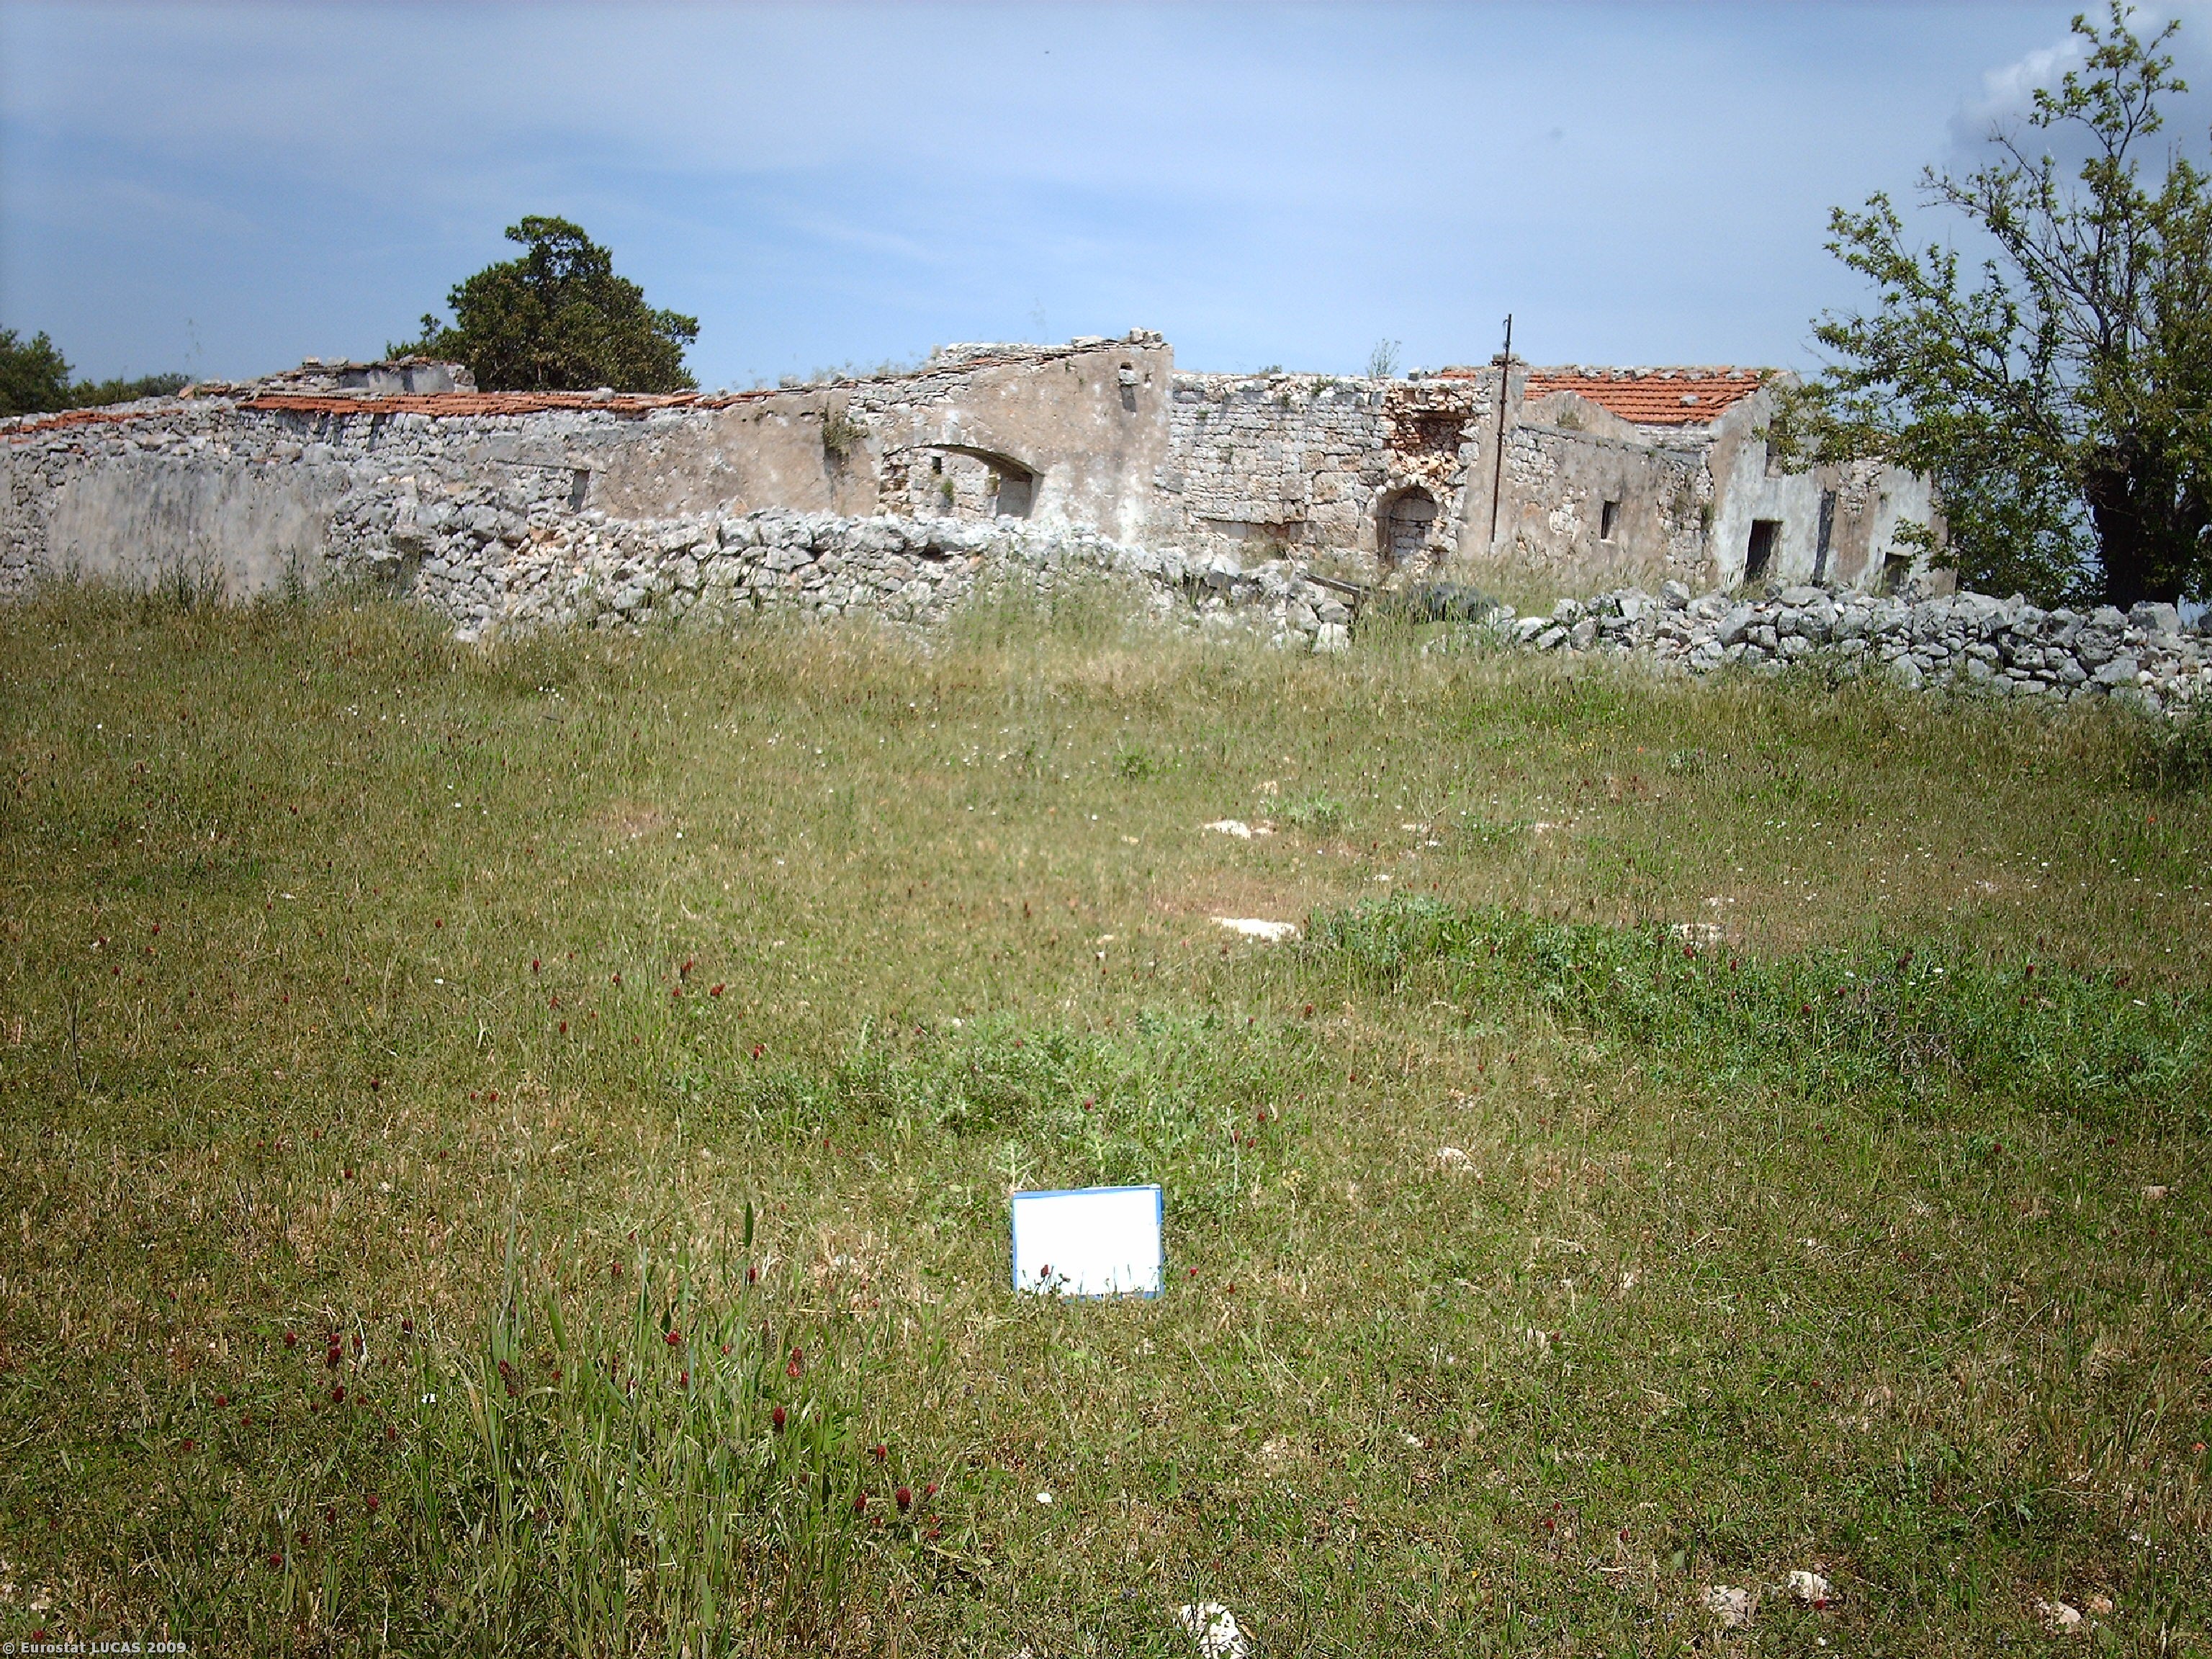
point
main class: Grassland
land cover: Grassland without tree/shrub cover
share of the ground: > 75 %
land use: Agriculture (excluding fallow land and kitchen gardens)
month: May
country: IT
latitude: 40.8316
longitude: 17.0335
